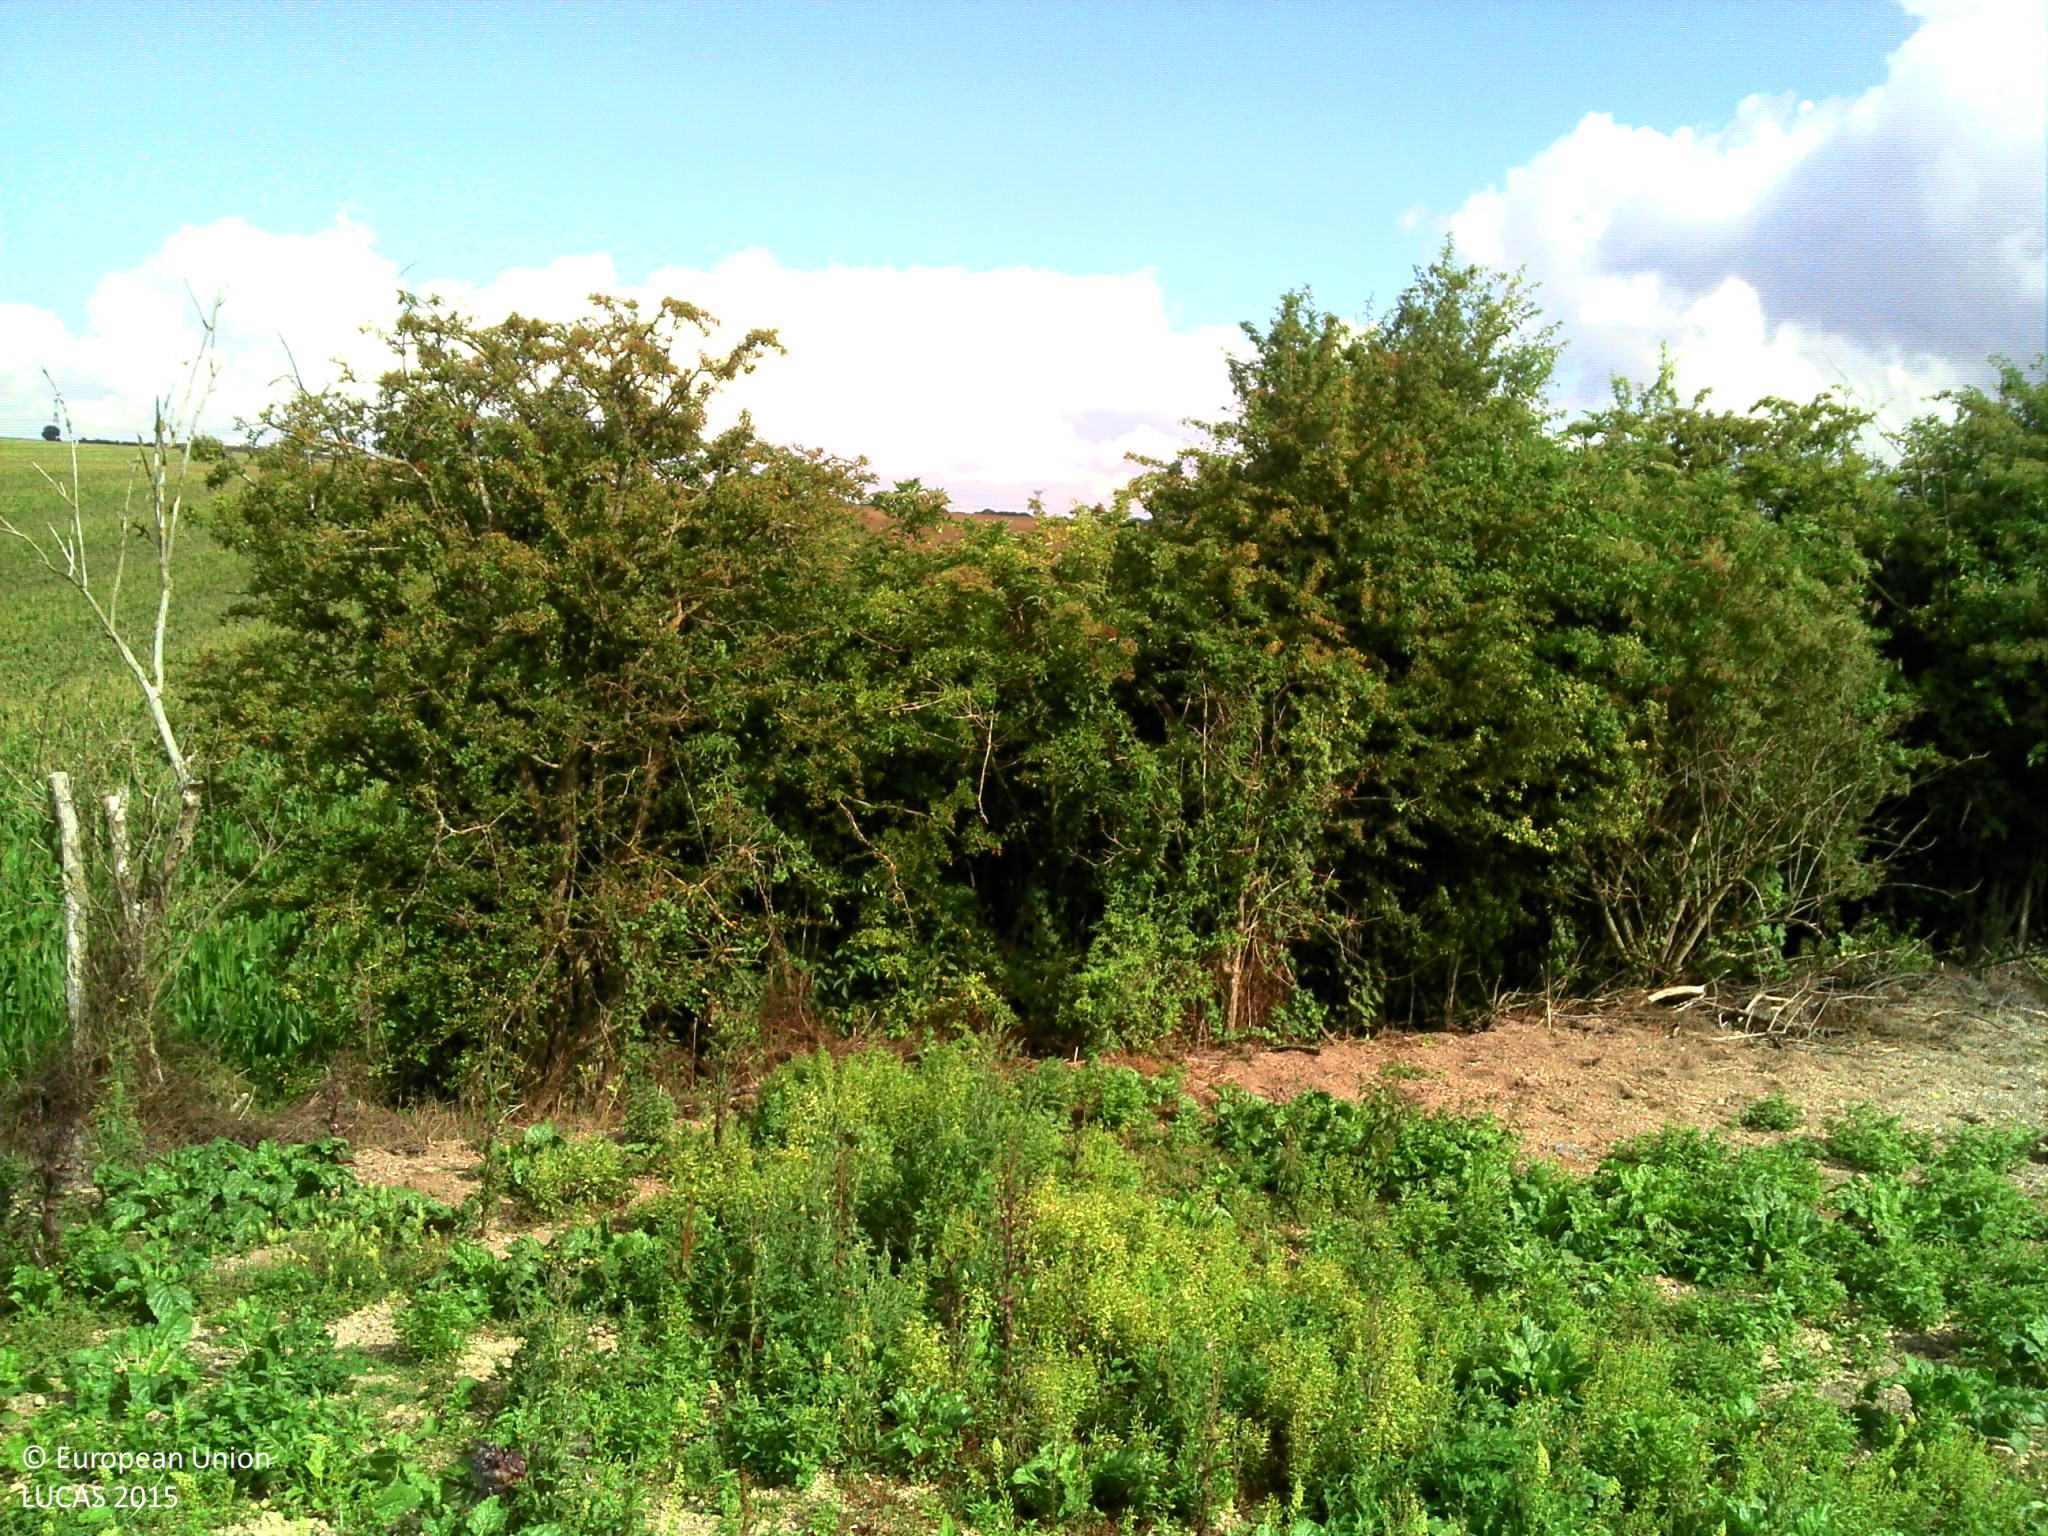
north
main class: Cropland
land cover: Rape and turnip rape
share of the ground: > 75 %
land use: Agriculture (excluding fallow land and kitchen gardens)
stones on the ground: 25 - 50 %
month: July
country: FR
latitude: 50.0286
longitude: 2.5194
